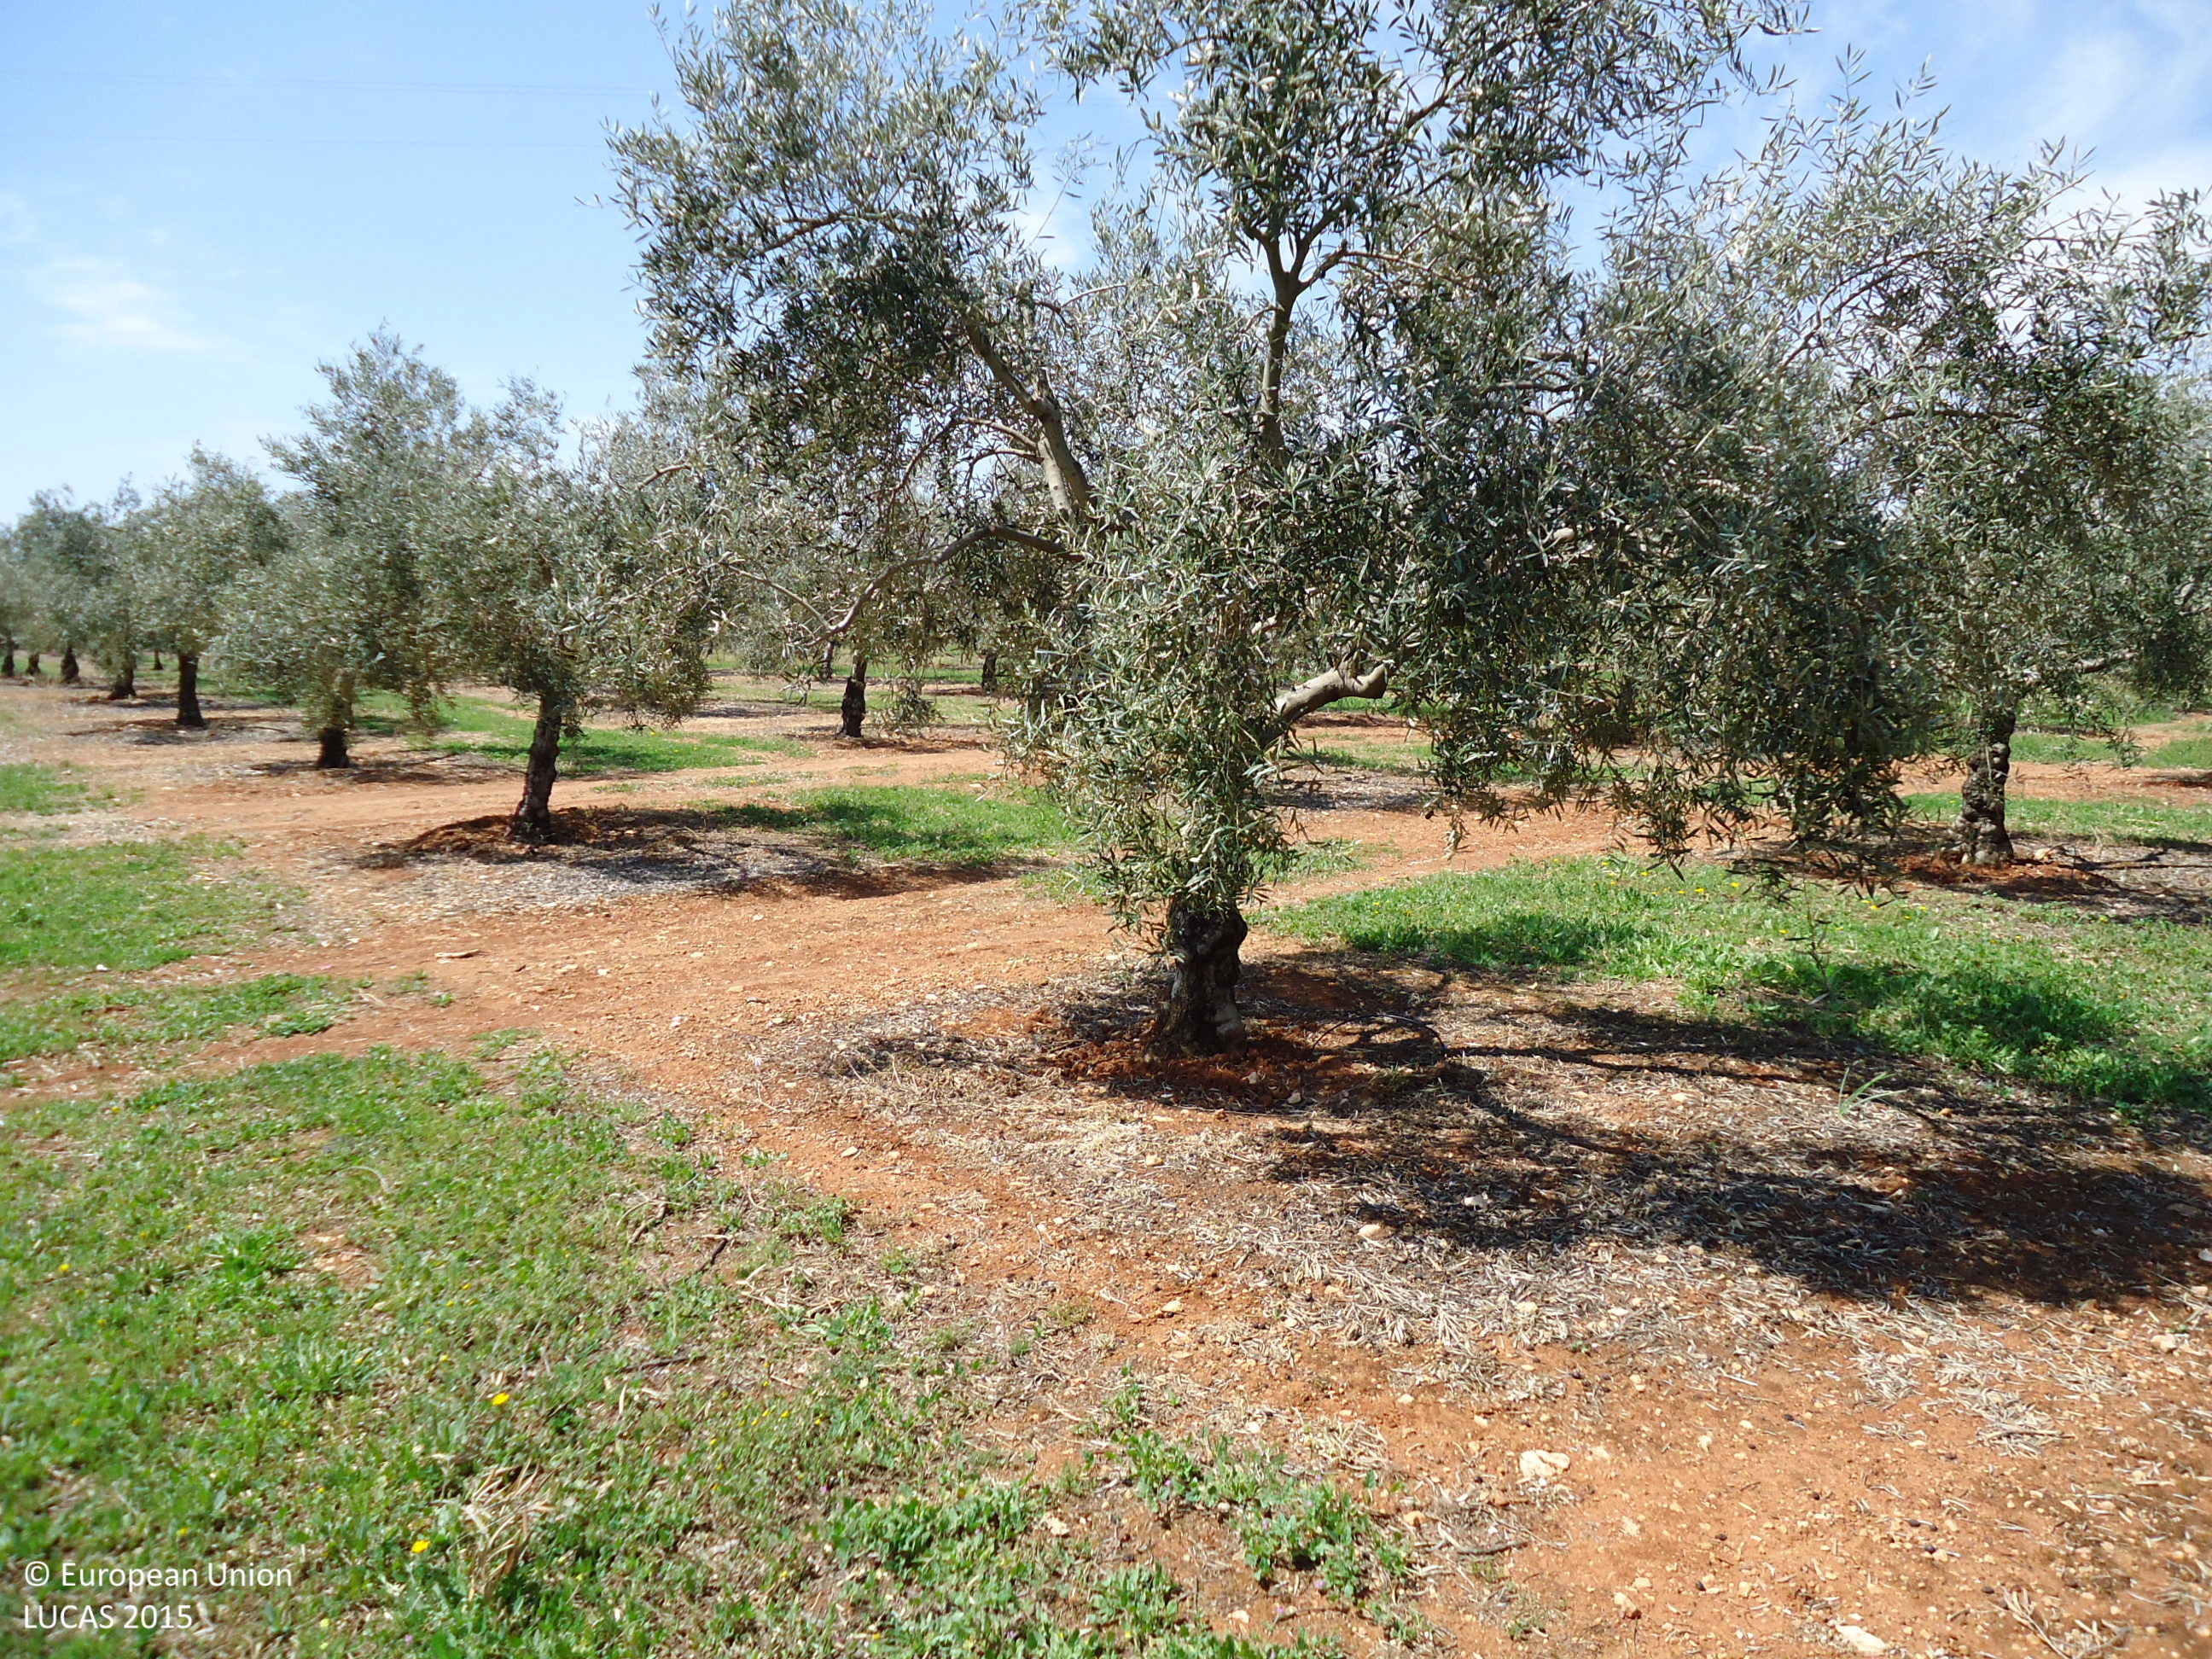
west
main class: Cropland
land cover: Olive groves
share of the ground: 25 - 50 %
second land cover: Spontaneously vegetated surfaces
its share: 50 - 75 %
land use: Agriculture (excluding fallow land and kitchen gardens)
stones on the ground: < 10 %
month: April
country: ES
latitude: 37.0735
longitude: -4.8370
